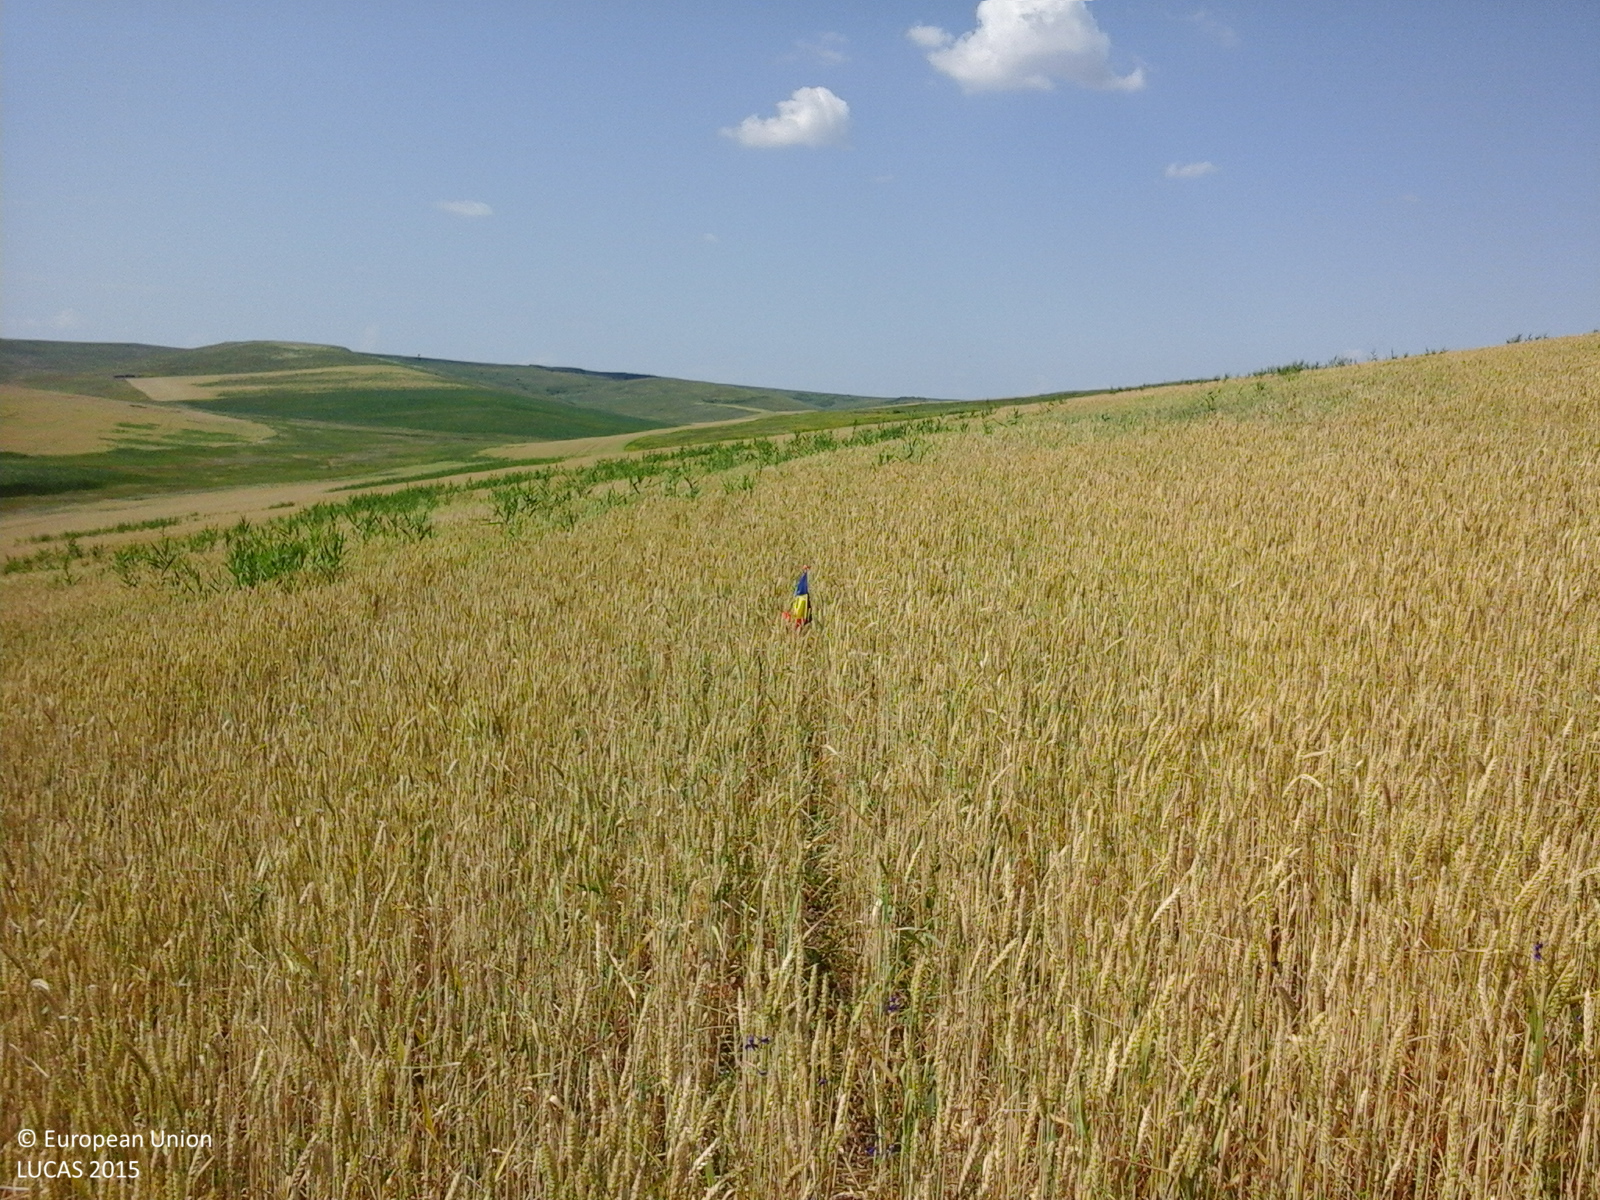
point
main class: Cropland
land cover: Common wheat
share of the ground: > 75 %
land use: Agriculture (excluding fallow land and kitchen gardens)
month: June
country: RO
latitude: 47.2431
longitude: 27.4341
